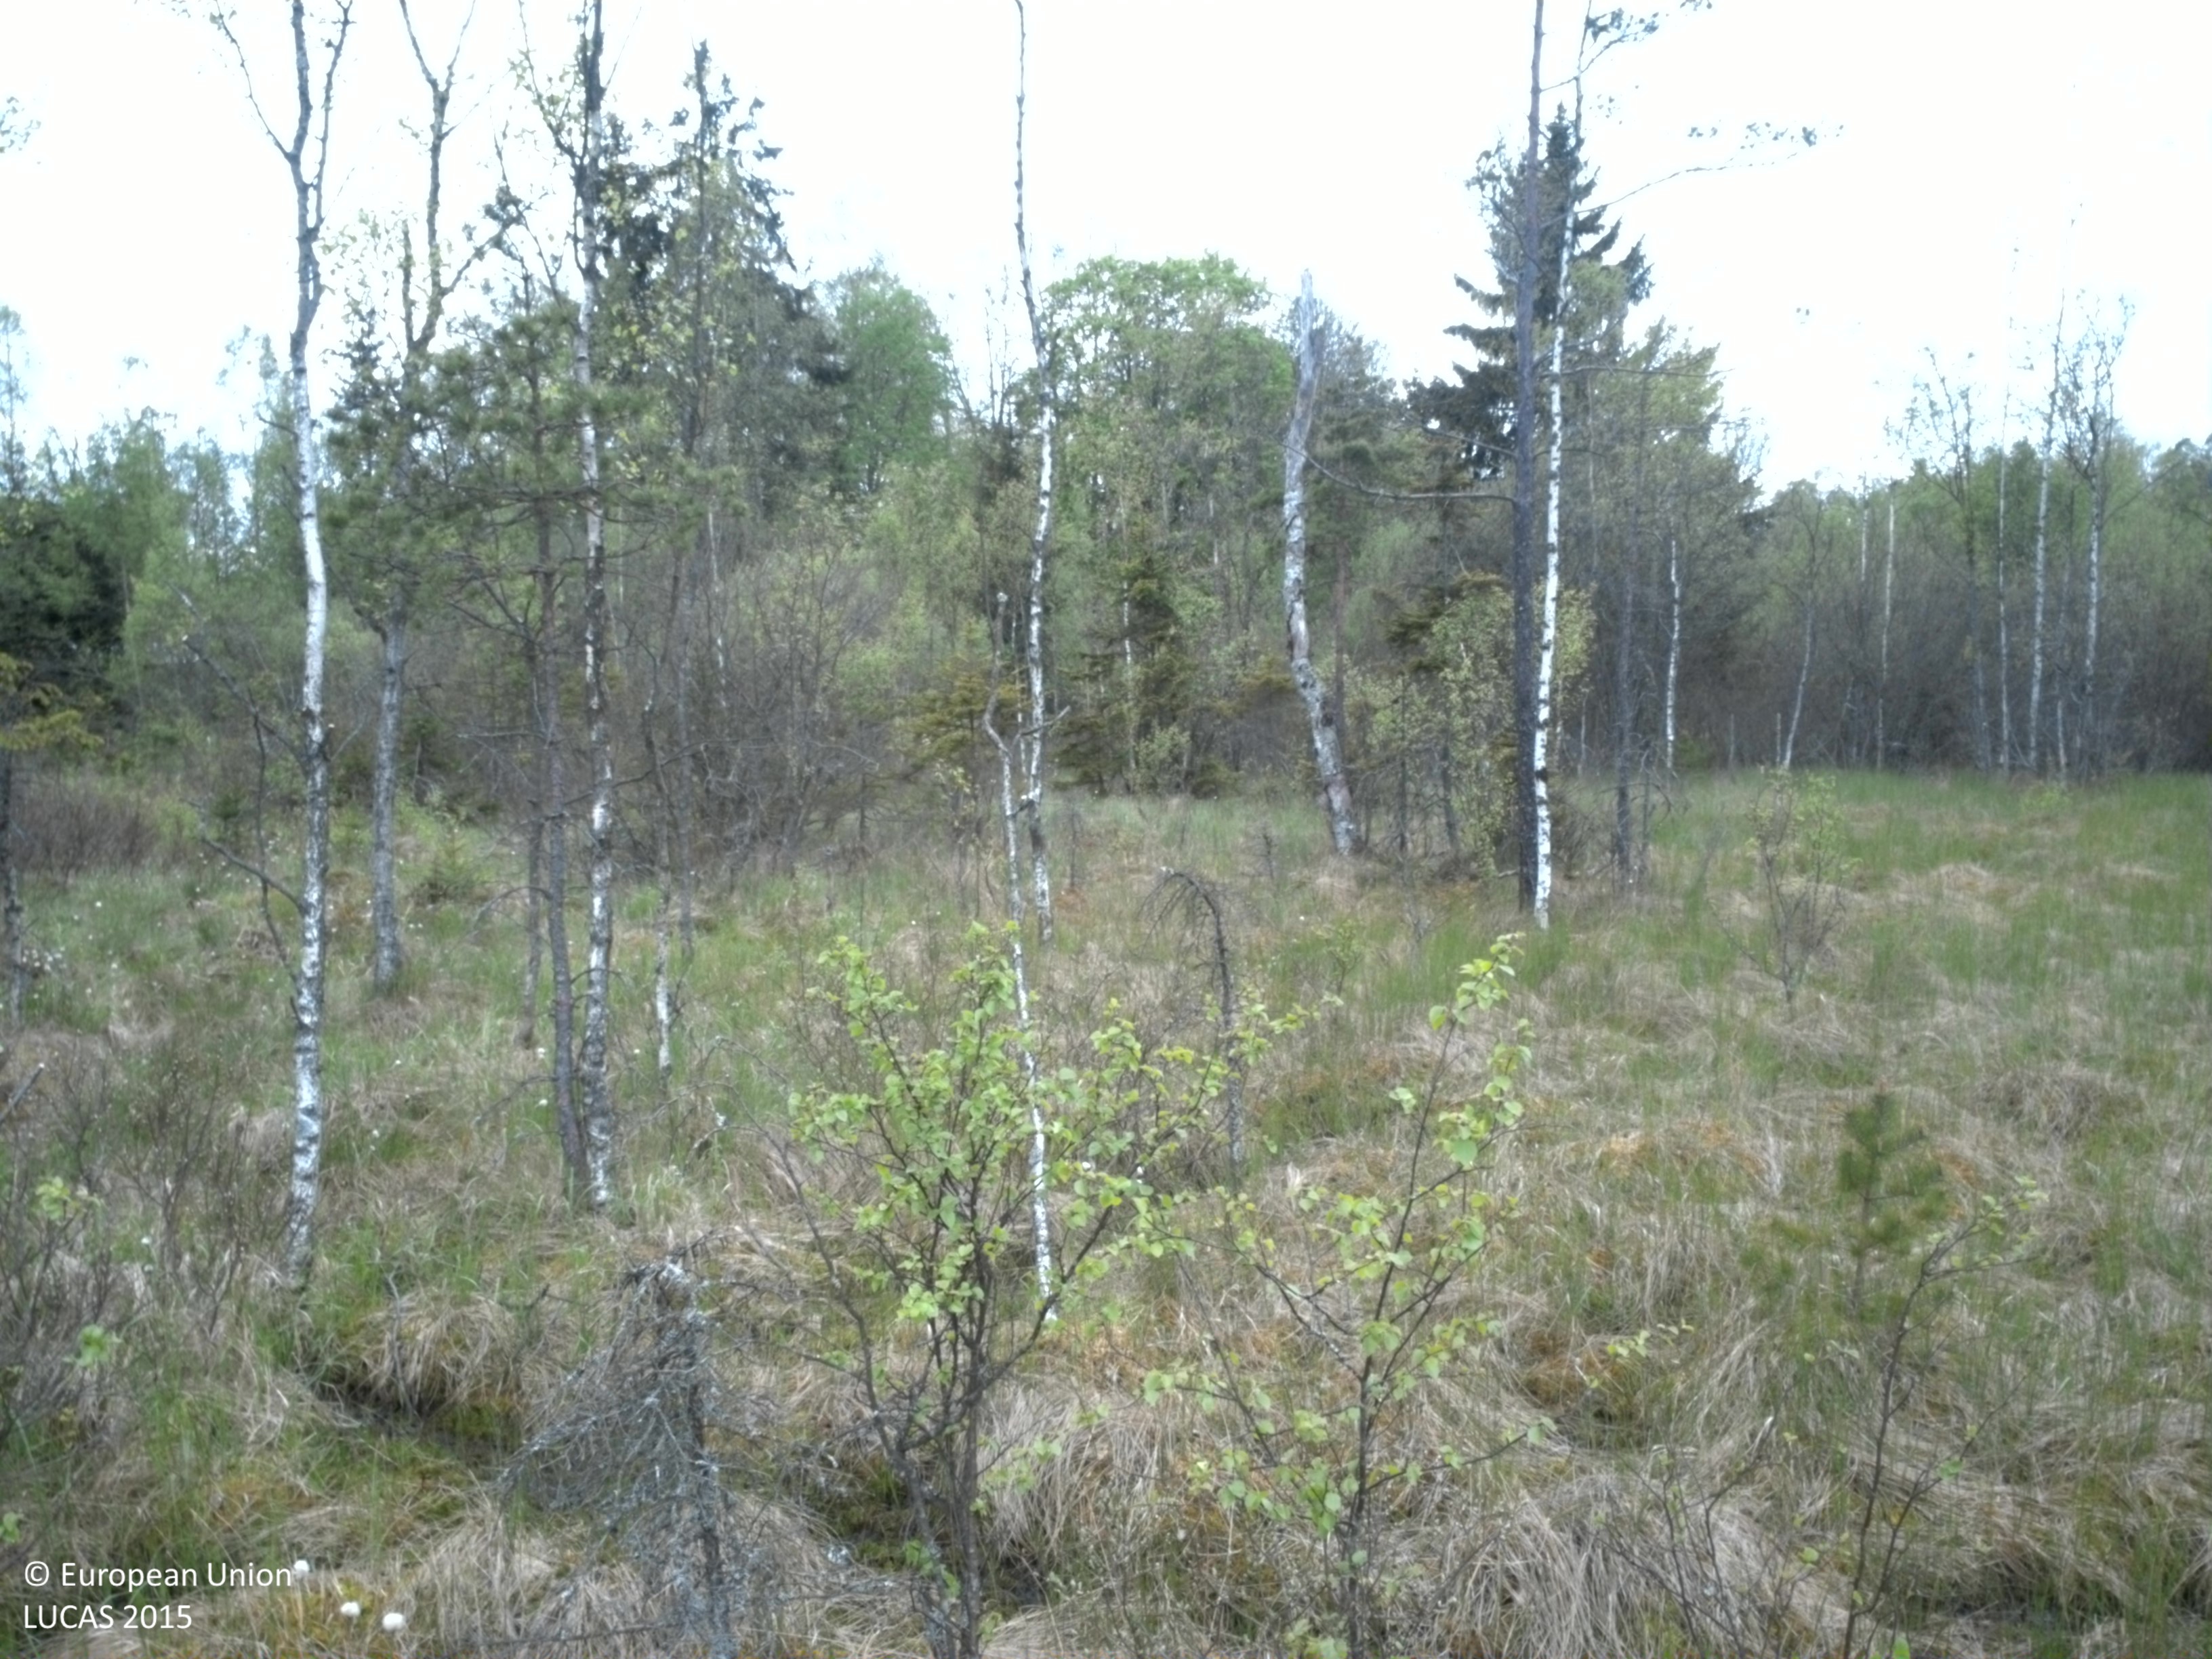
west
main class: Woodland
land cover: Broadleaved woodland
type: hemiboreal forest and nemoral coniferous forest and mixed broadleaved-coniferous forest
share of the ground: 25 - 50 %
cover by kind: broadleaved forest trees 40 %, herbaceous plants 30 %, lichens and mosses 30 %
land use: Forestry
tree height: > 5 m
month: May
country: SE
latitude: 56.8109
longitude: 15.4527
